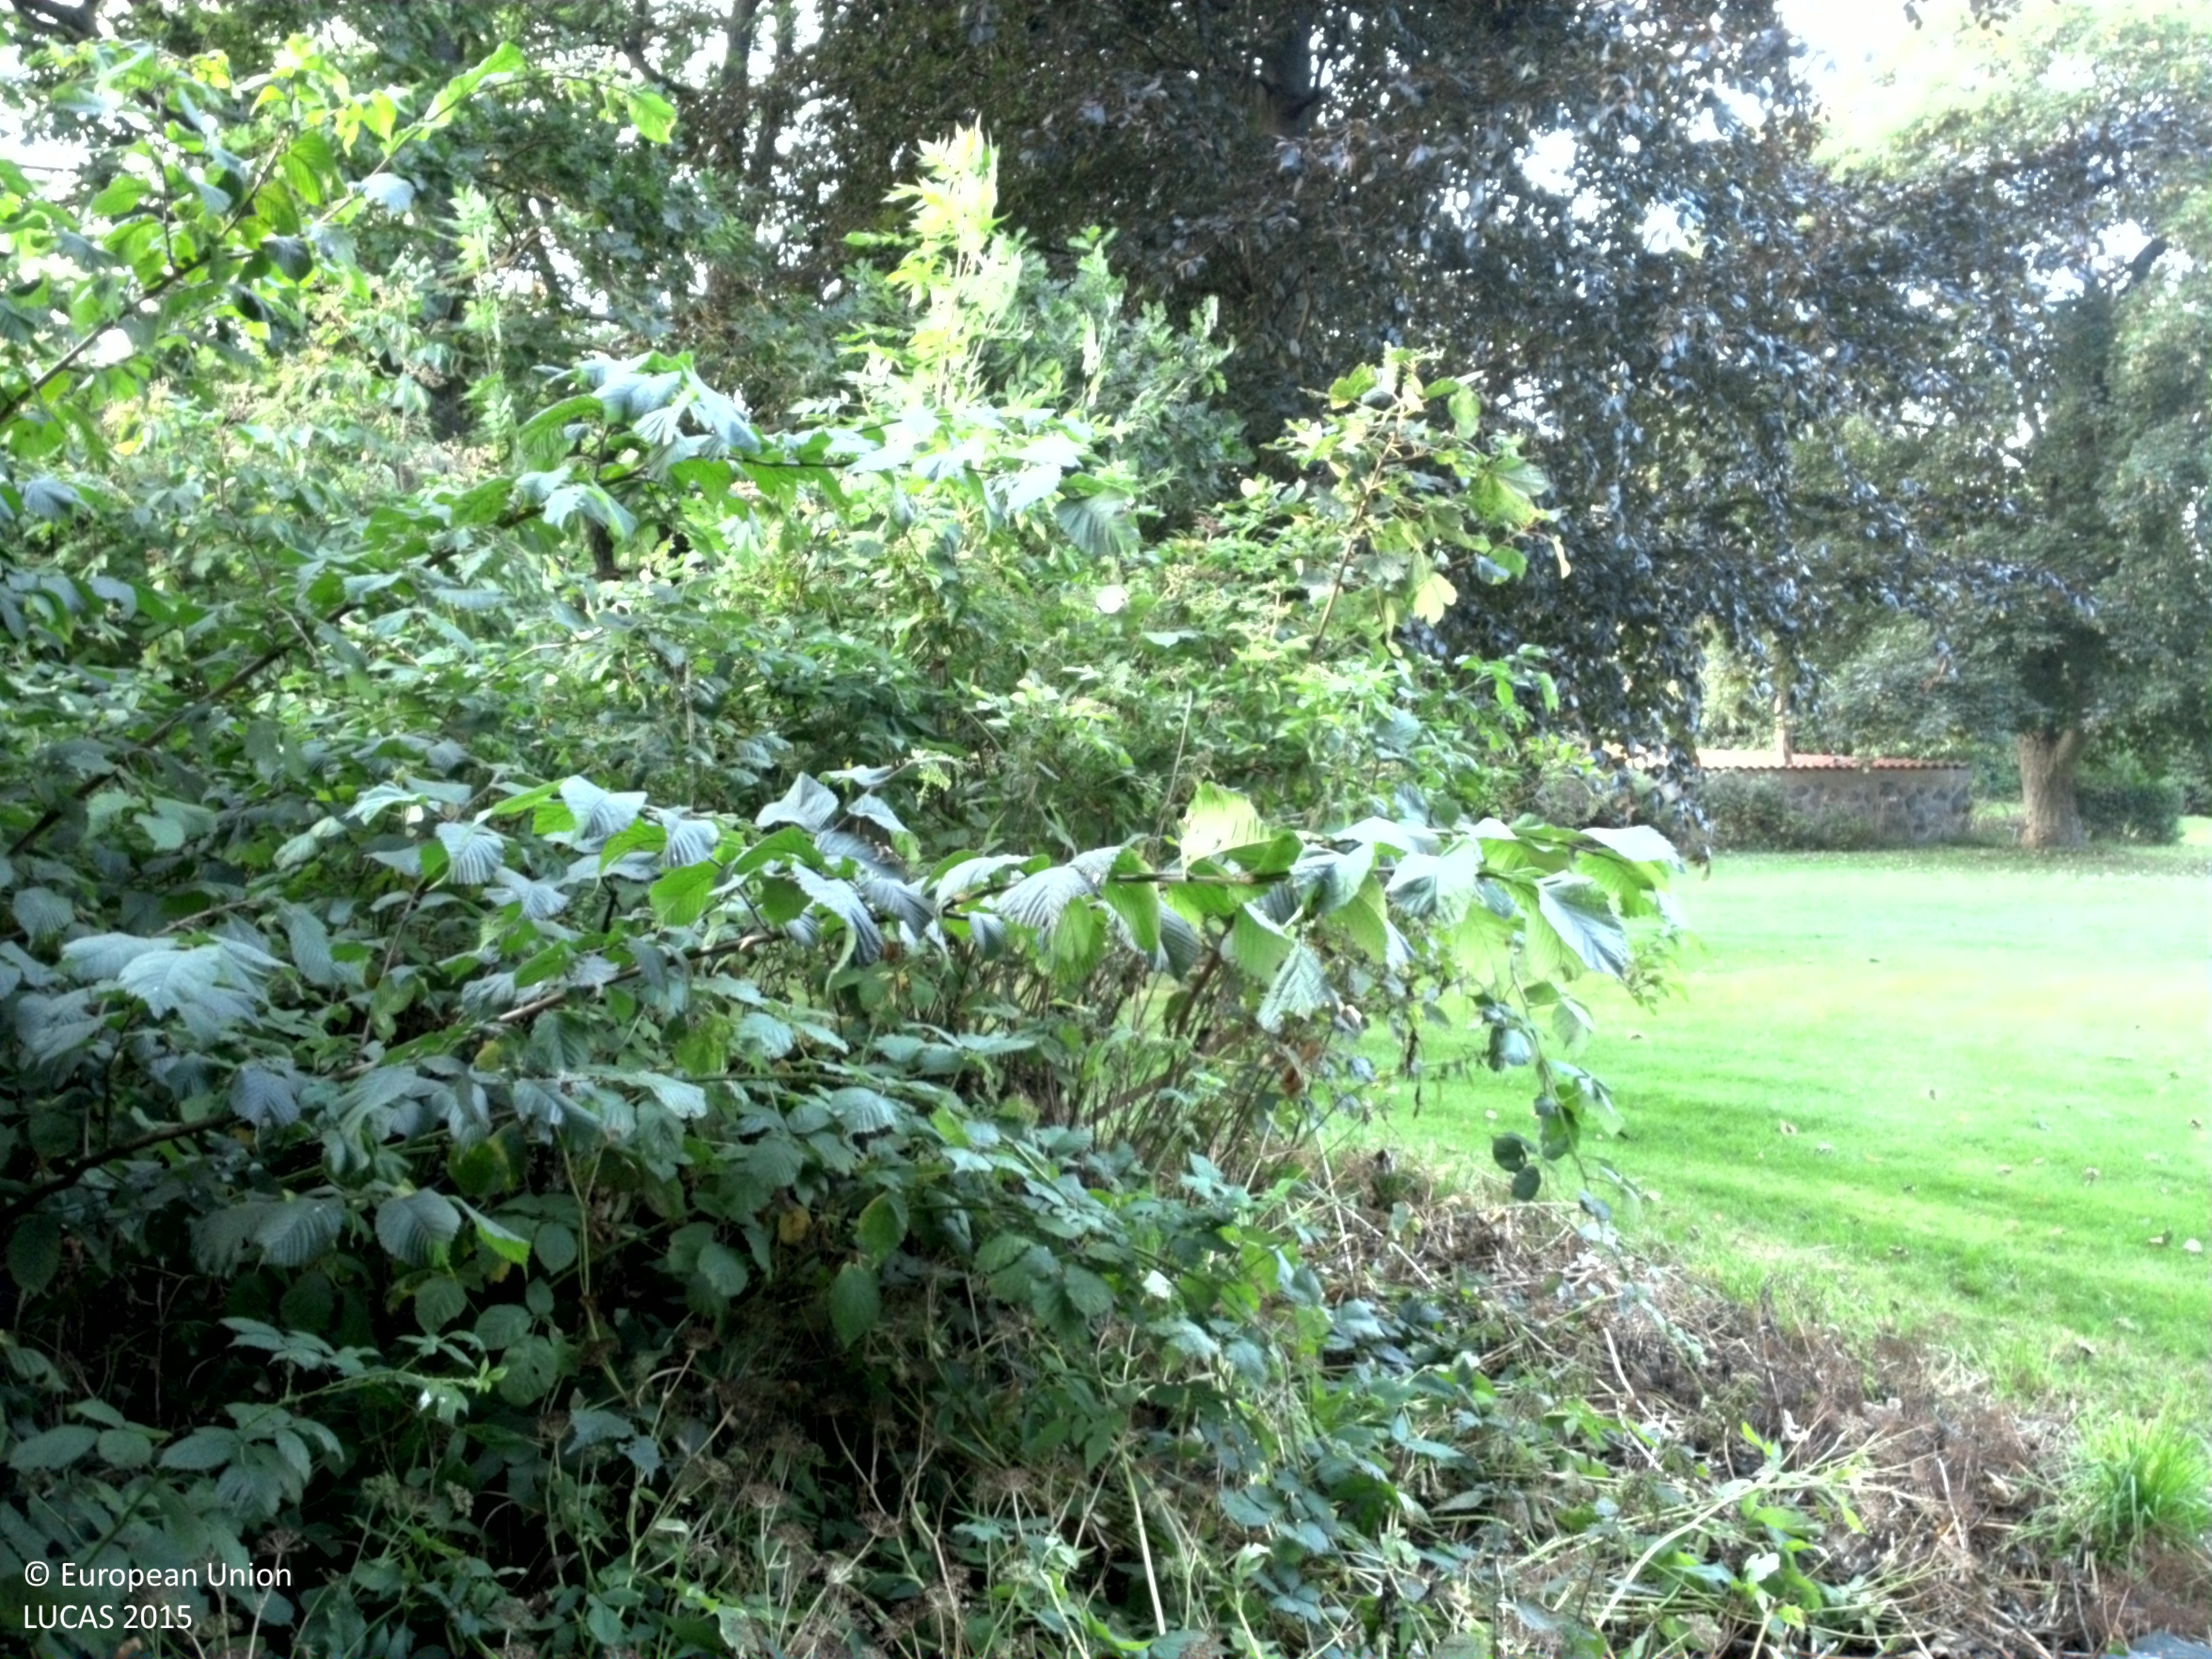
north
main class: Shrubland
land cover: Shrubland with sparse tree cover
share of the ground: 50 - 75 %
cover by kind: shrubs 60 %, herbaceous plants 35 %, broadleaved forest trees 5 %
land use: Residential
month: August
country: SE
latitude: 55.4350
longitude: 13.6176
